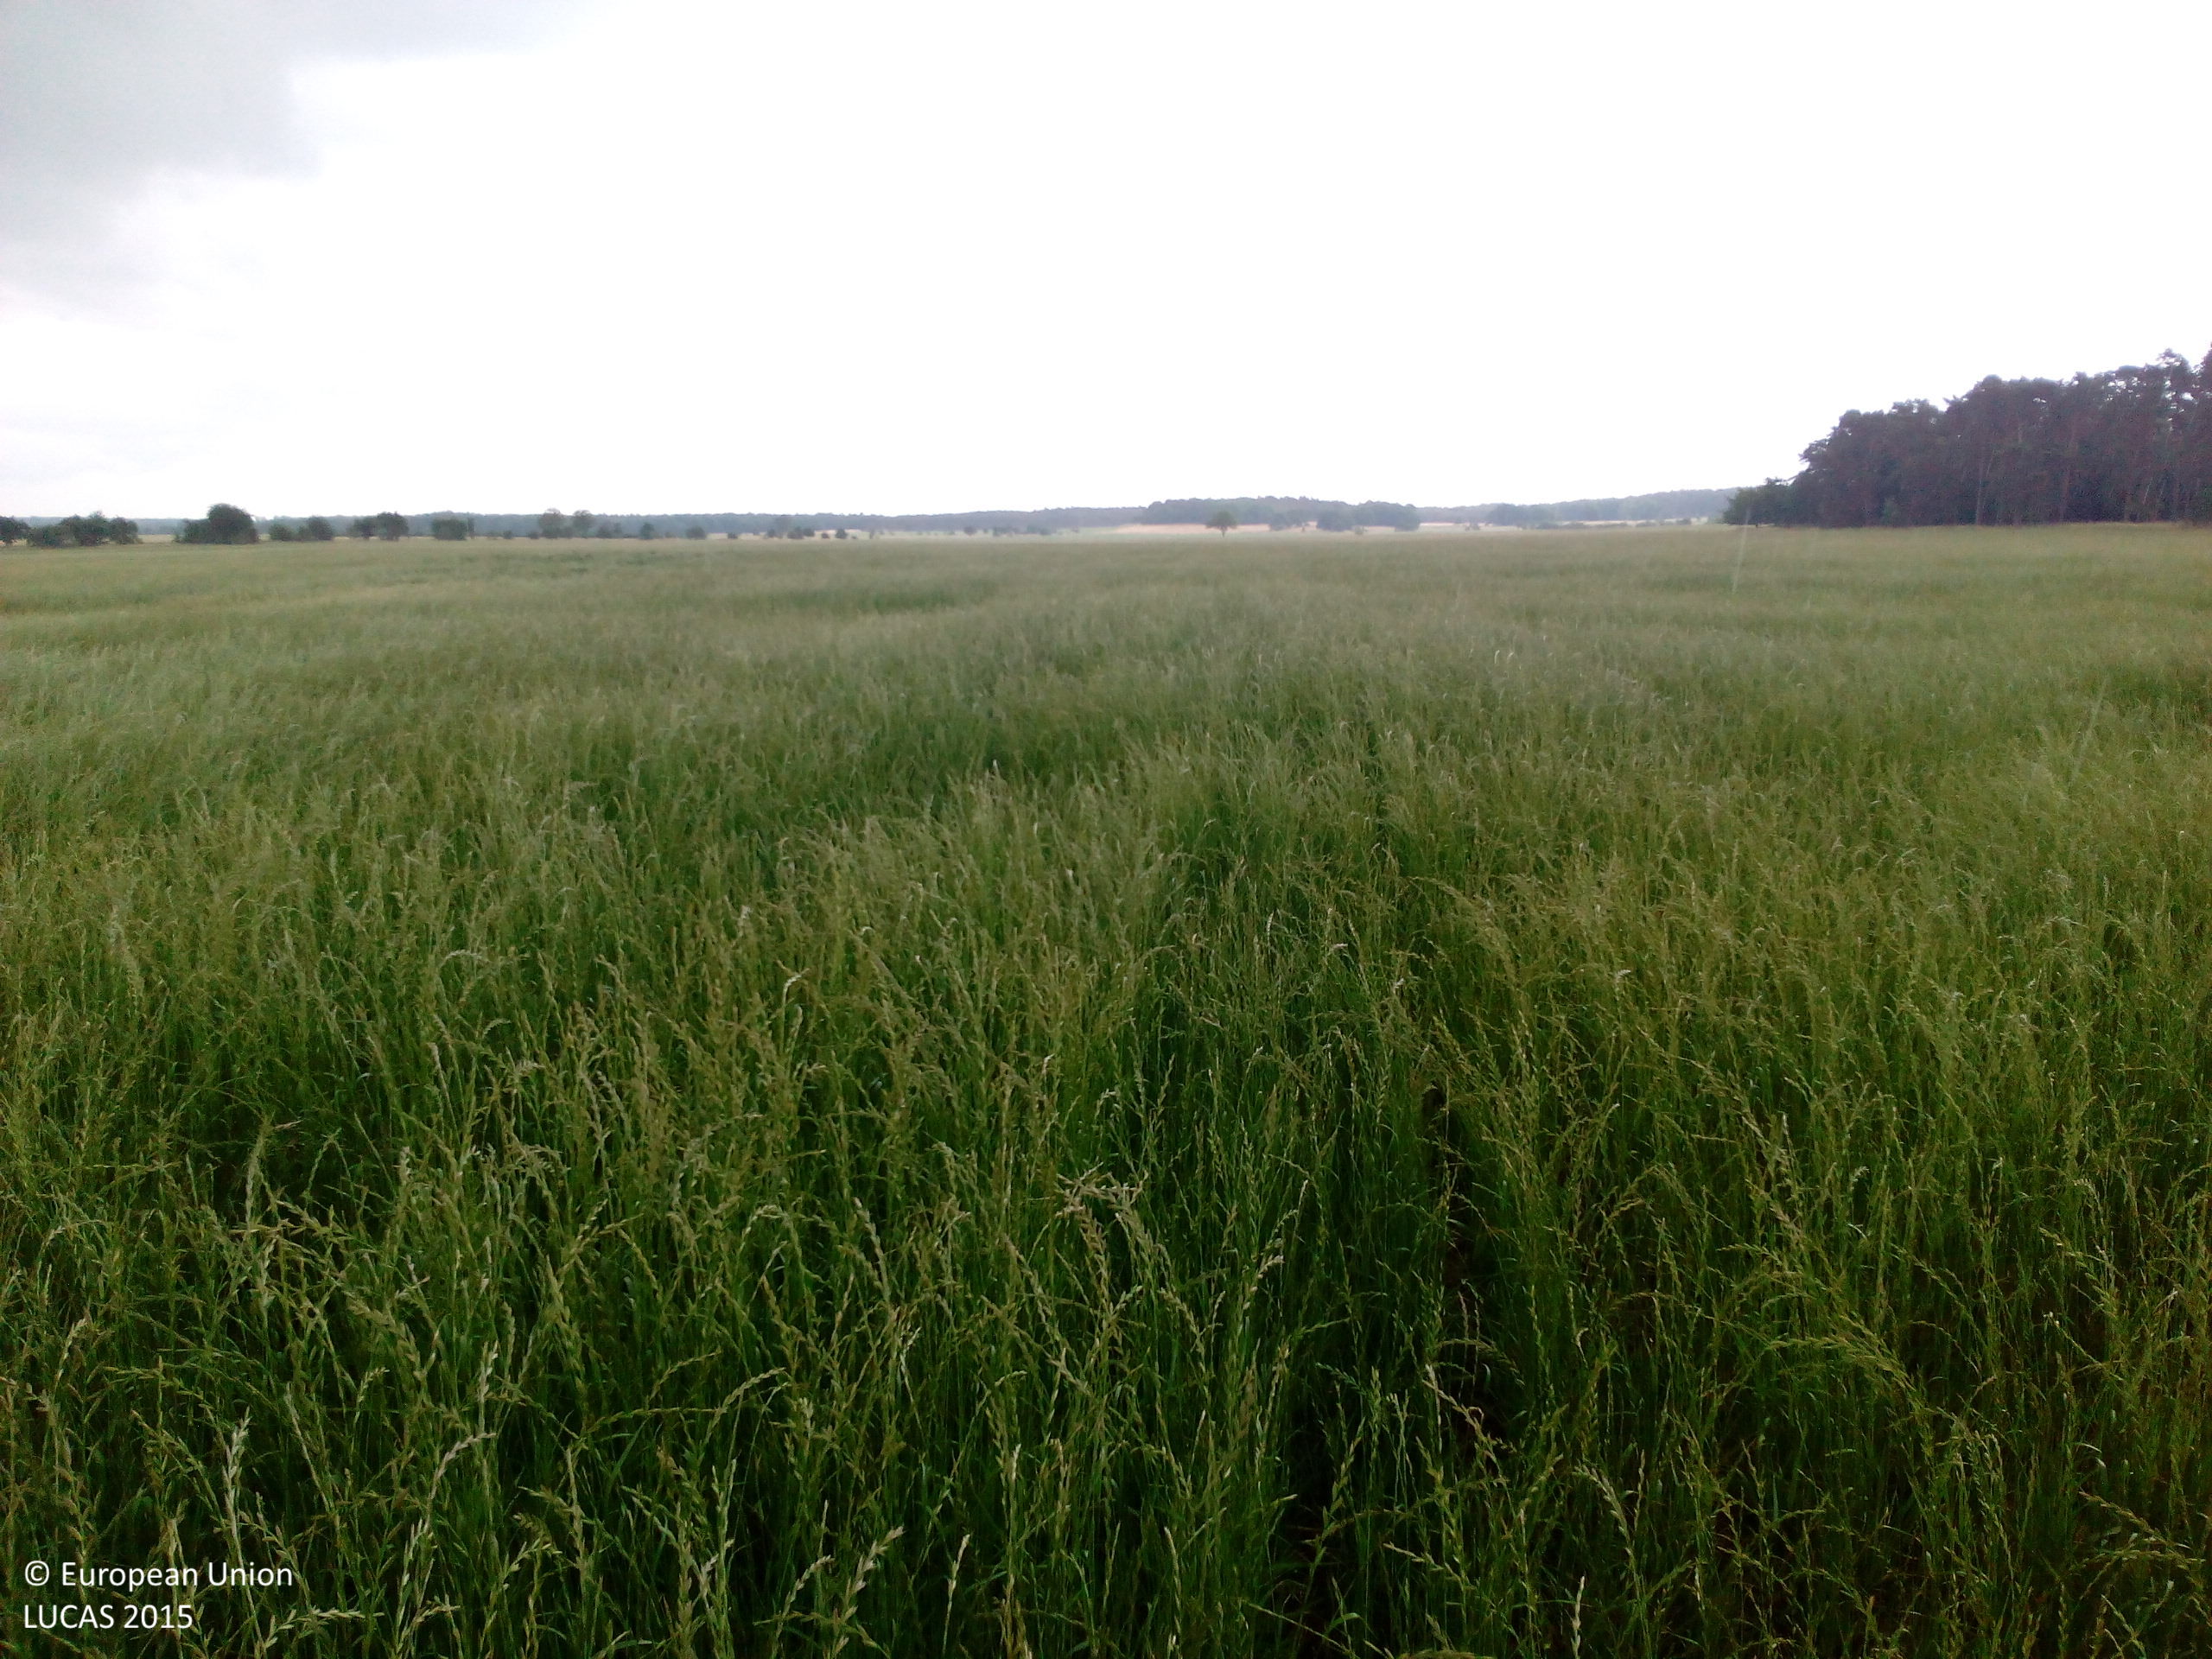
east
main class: Cropland
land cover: Temporary grasslands
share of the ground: > 75 %
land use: Agriculture (excluding fallow land and kitchen gardens)
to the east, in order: Temporary grasslands
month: June
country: DE
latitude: 52.3721
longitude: 11.1306
